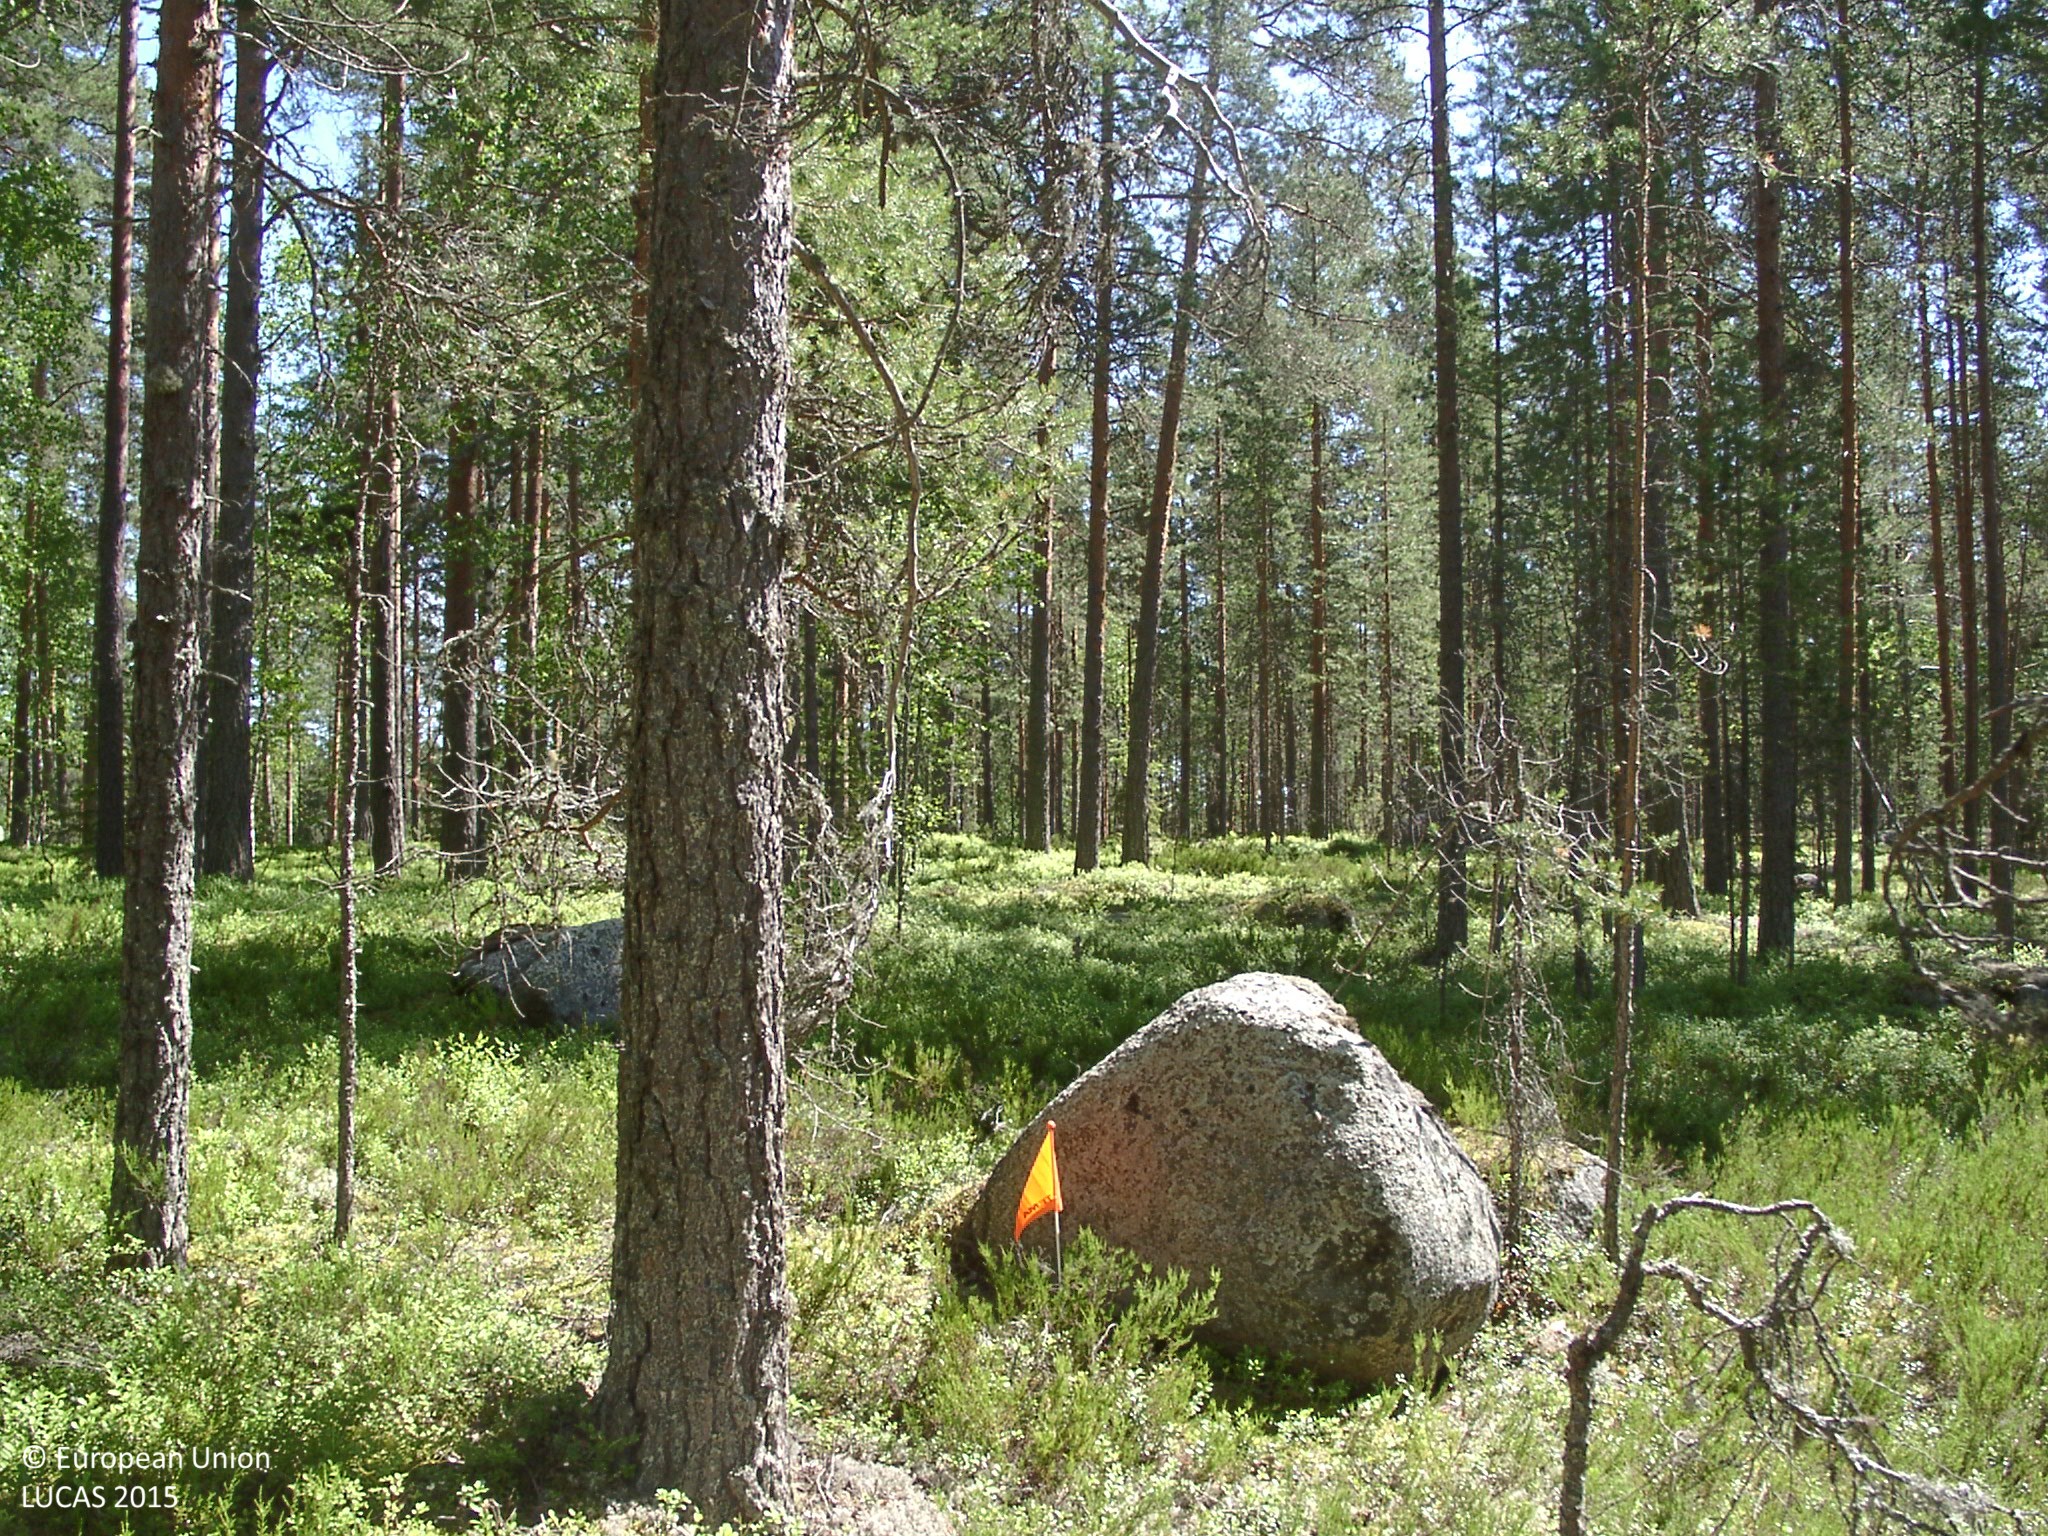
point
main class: Woodland
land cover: Pine dominated coniferous woodland
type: boreal forest
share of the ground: 50 - 75 %
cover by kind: coniferous forest trees 50 %, shrubs 30 %, lichens and mosses 10 %, broadleaved forest trees 5 %, consolidated bare surface 5 %
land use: Semi-natural and natural areas not in use
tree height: > 5 m
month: July
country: FI
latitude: 61.9808
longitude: 25.5553
